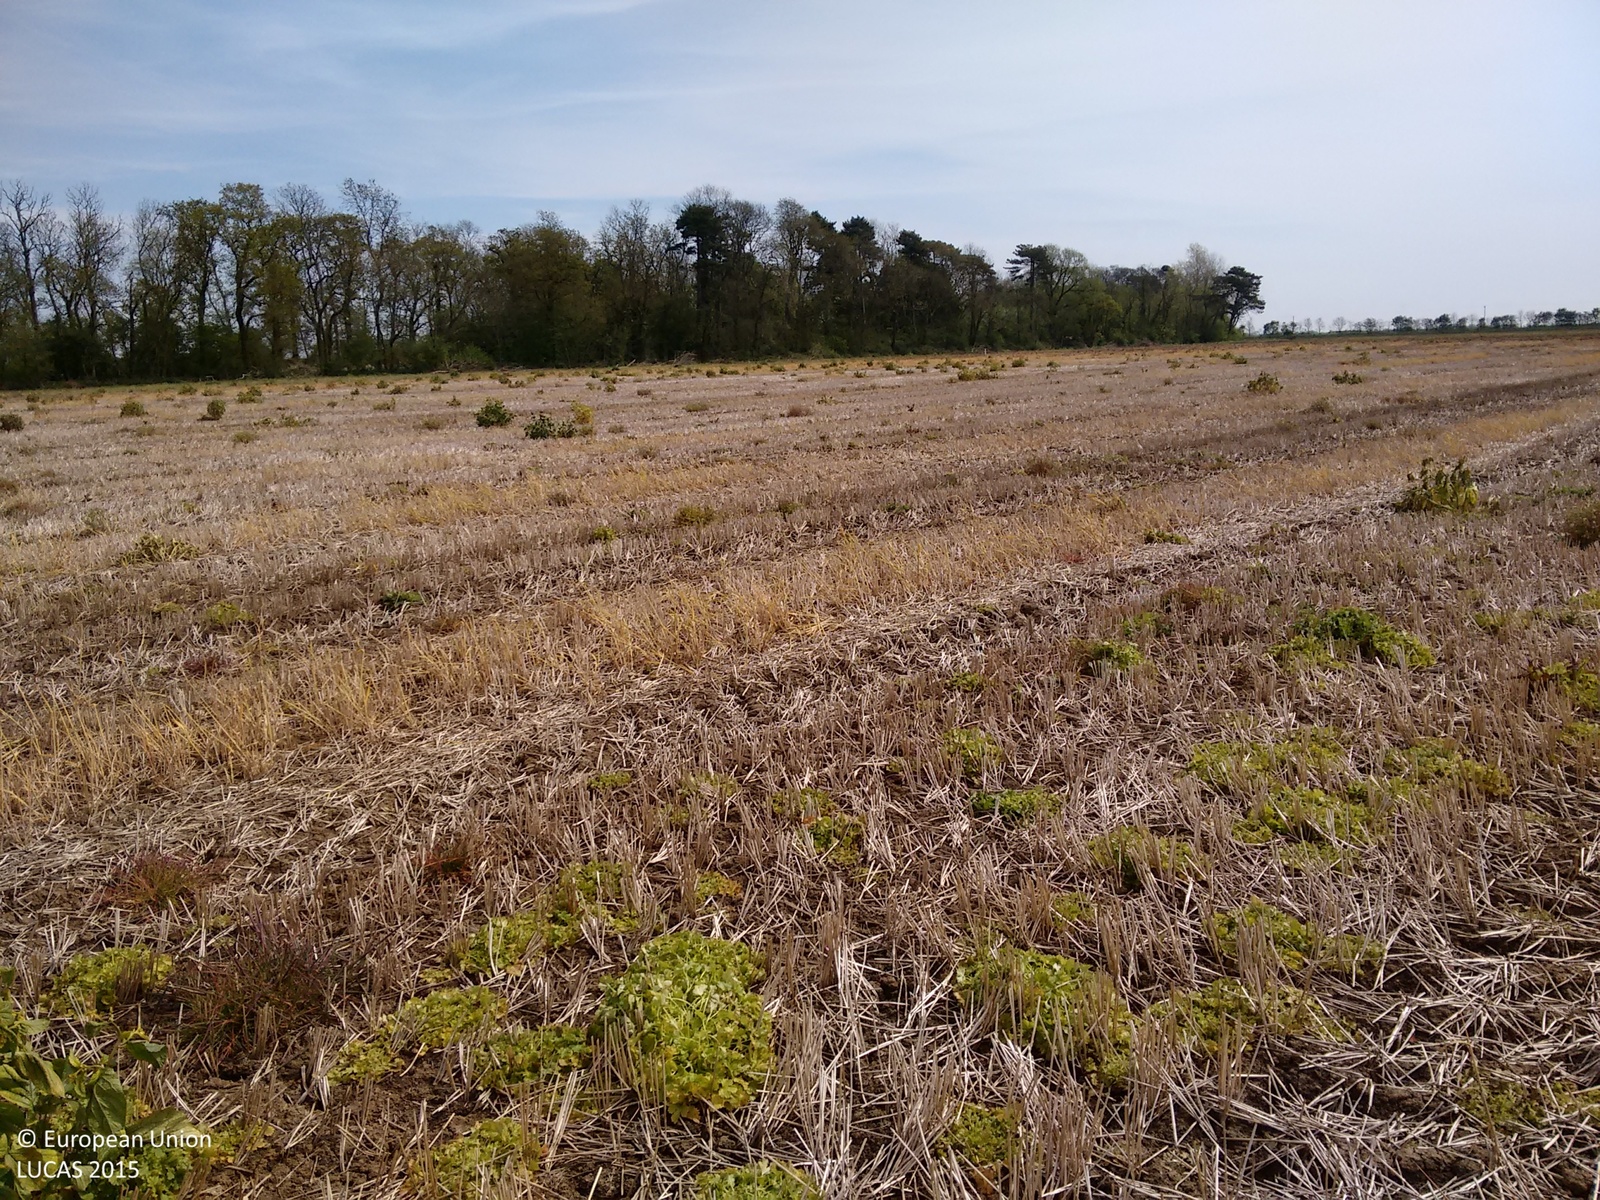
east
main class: Grassland
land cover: Spontaneously vegetated surfaces
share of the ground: 25 - 50 %
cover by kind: herbaceous plants 60 %, unconsolidated bare surface 40 %
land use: Agriculture (excluding fallow land and kitchen gardens)
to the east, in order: Spontaneously vegetated surfaces; Other bare soil; Tracks; Grass margins; Ditches and canals; Grass margins; Broadleaved woodland
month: May
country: GB
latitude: 53.3599
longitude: 0.1275
